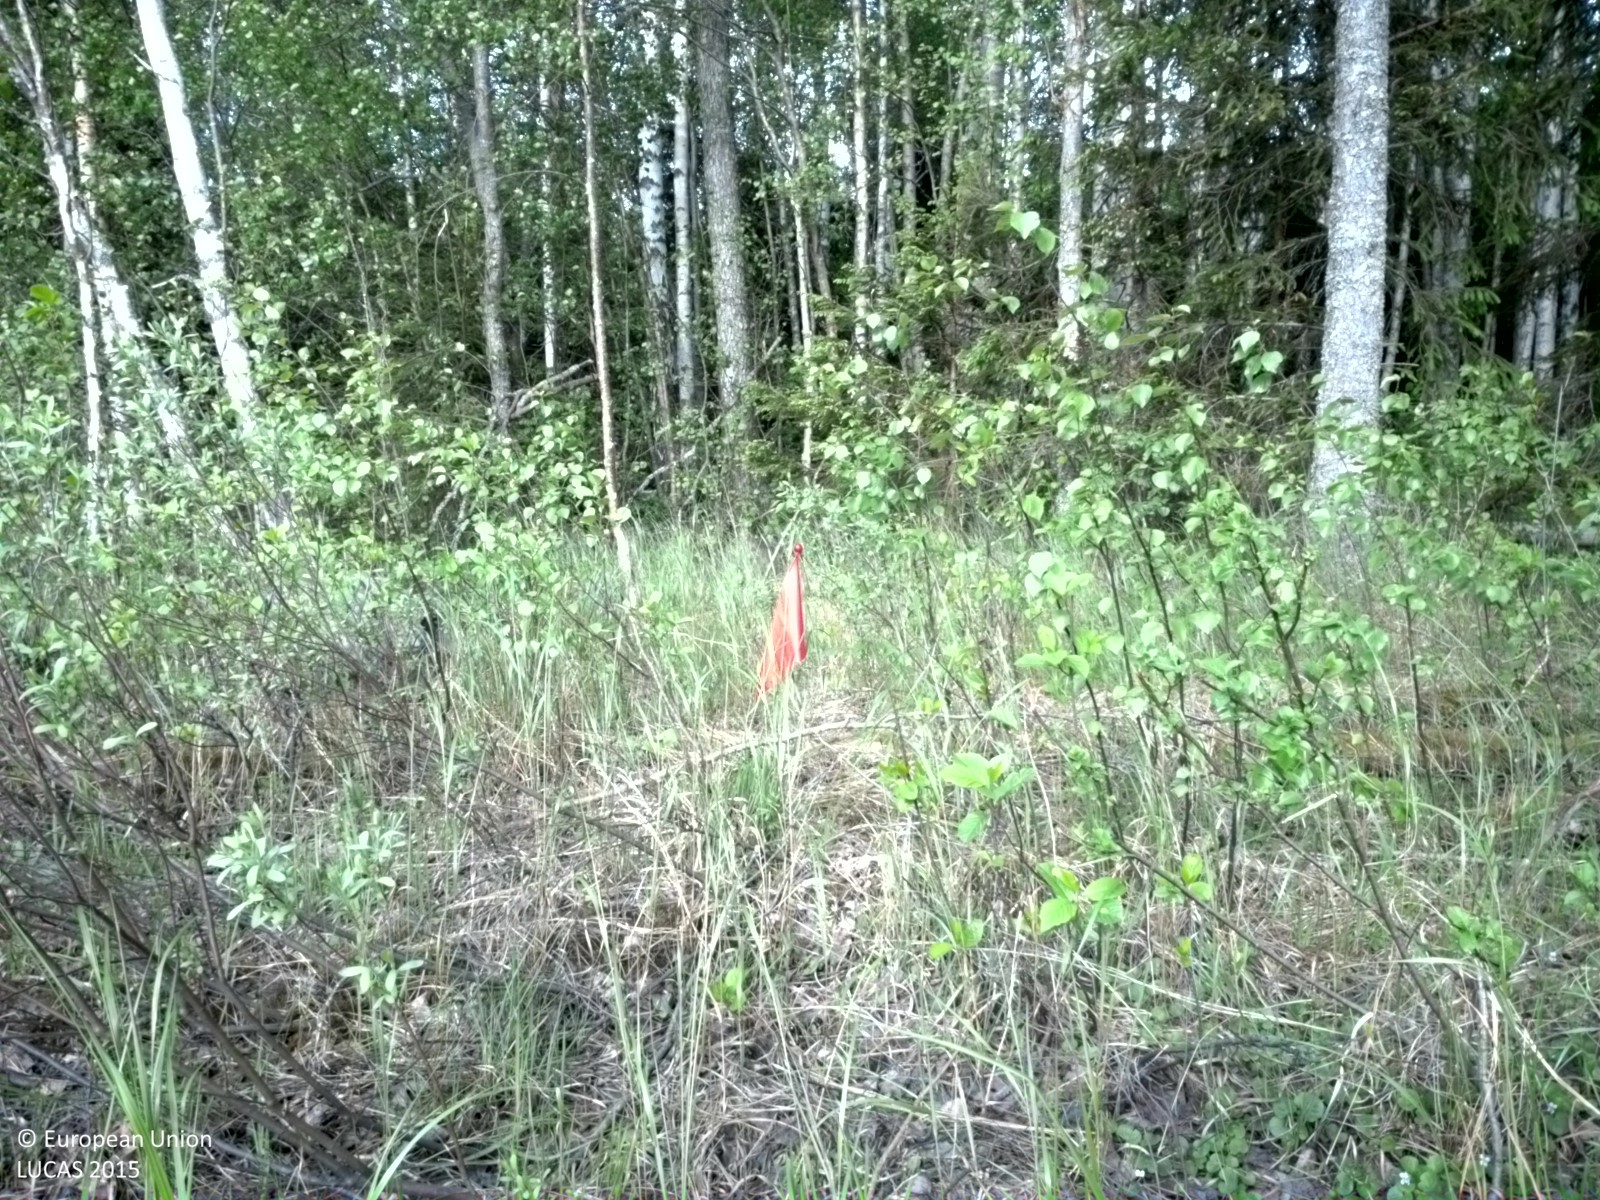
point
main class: Woodland
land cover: Broadleaved woodland
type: non-riverine alder, birch or aspen forest
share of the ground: 25 - 50 %
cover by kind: broadleaved forest trees 45 %, herbaceous plants 30 %, shrubs 15 %, coniferous forest trees 5 %, lichens and mosses 5 %
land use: Forestry
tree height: > 5 m
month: June
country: SE
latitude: 60.3036
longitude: 17.2113
